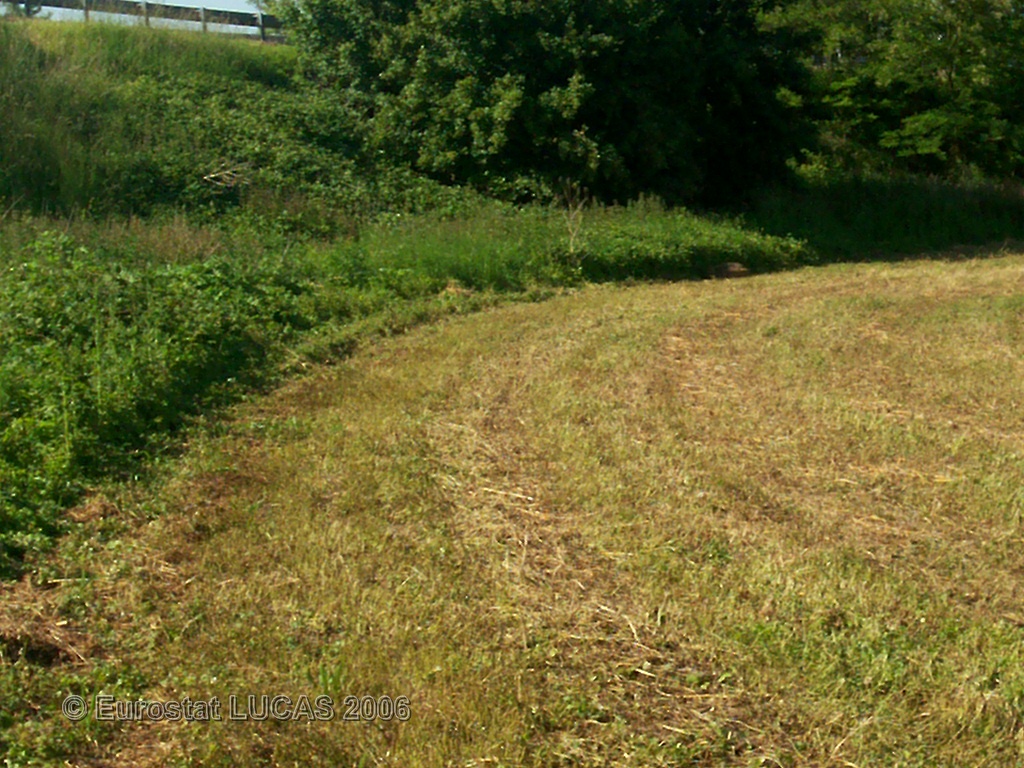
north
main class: Cropland
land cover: Lucerne
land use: Agriculture (excluding fallow land and kitchen gardens)
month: June
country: FR
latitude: 48.7237
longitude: 4.6278
